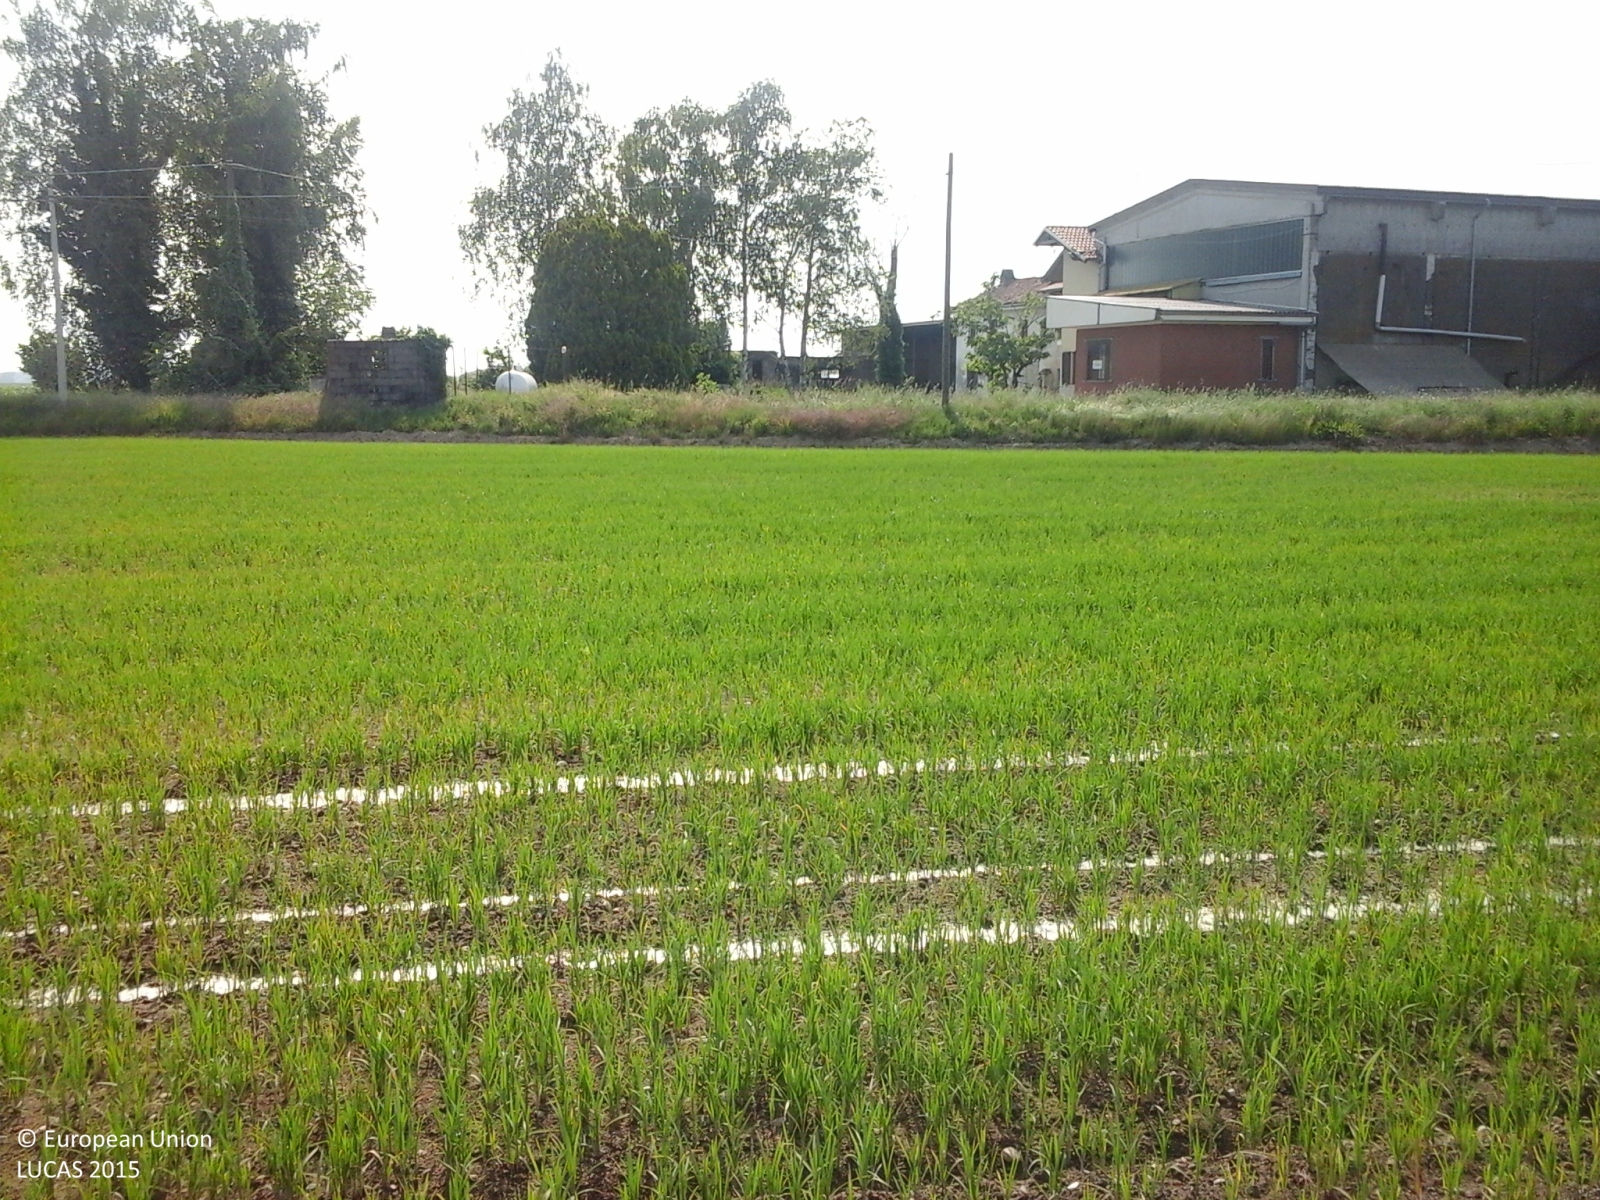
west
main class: Cropland
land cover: Rice
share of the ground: 25 - 50 %
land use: Agriculture (excluding fallow land and kitchen gardens)
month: May
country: IT
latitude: 45.3809
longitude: 8.2023
